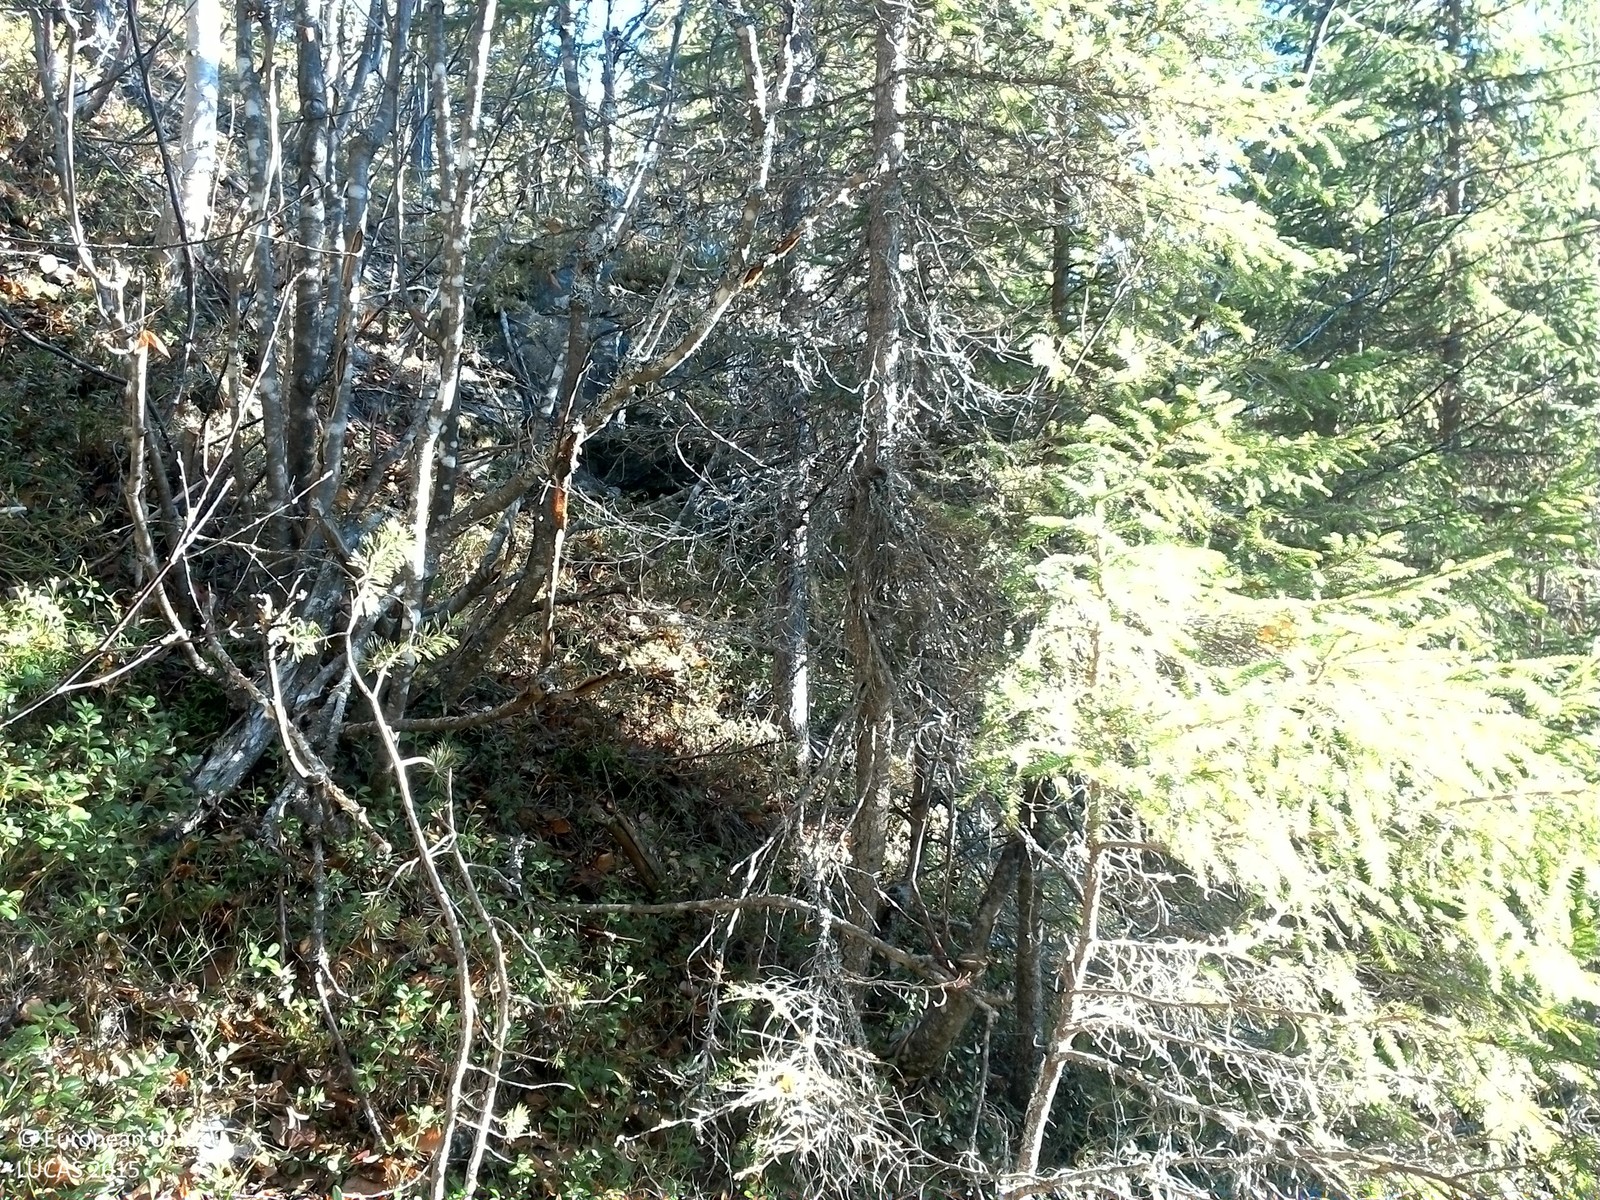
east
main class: Woodland
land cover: Spruce dominated mixed woodland
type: boreal forest
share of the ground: 25 - 50 %
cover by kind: coniferous forest trees 30 %, shrubs 30 %, lichens and mosses 20 %, broadleaved forest trees 10 %, consolidated bare surface 10 %
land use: Forestry
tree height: > 5 m
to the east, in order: Spruce dominated mixed woodland; Pine dominated mixed woodland; Spruce dominated mixed woodland
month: October
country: SE
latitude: 64.5052
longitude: 15.4050
